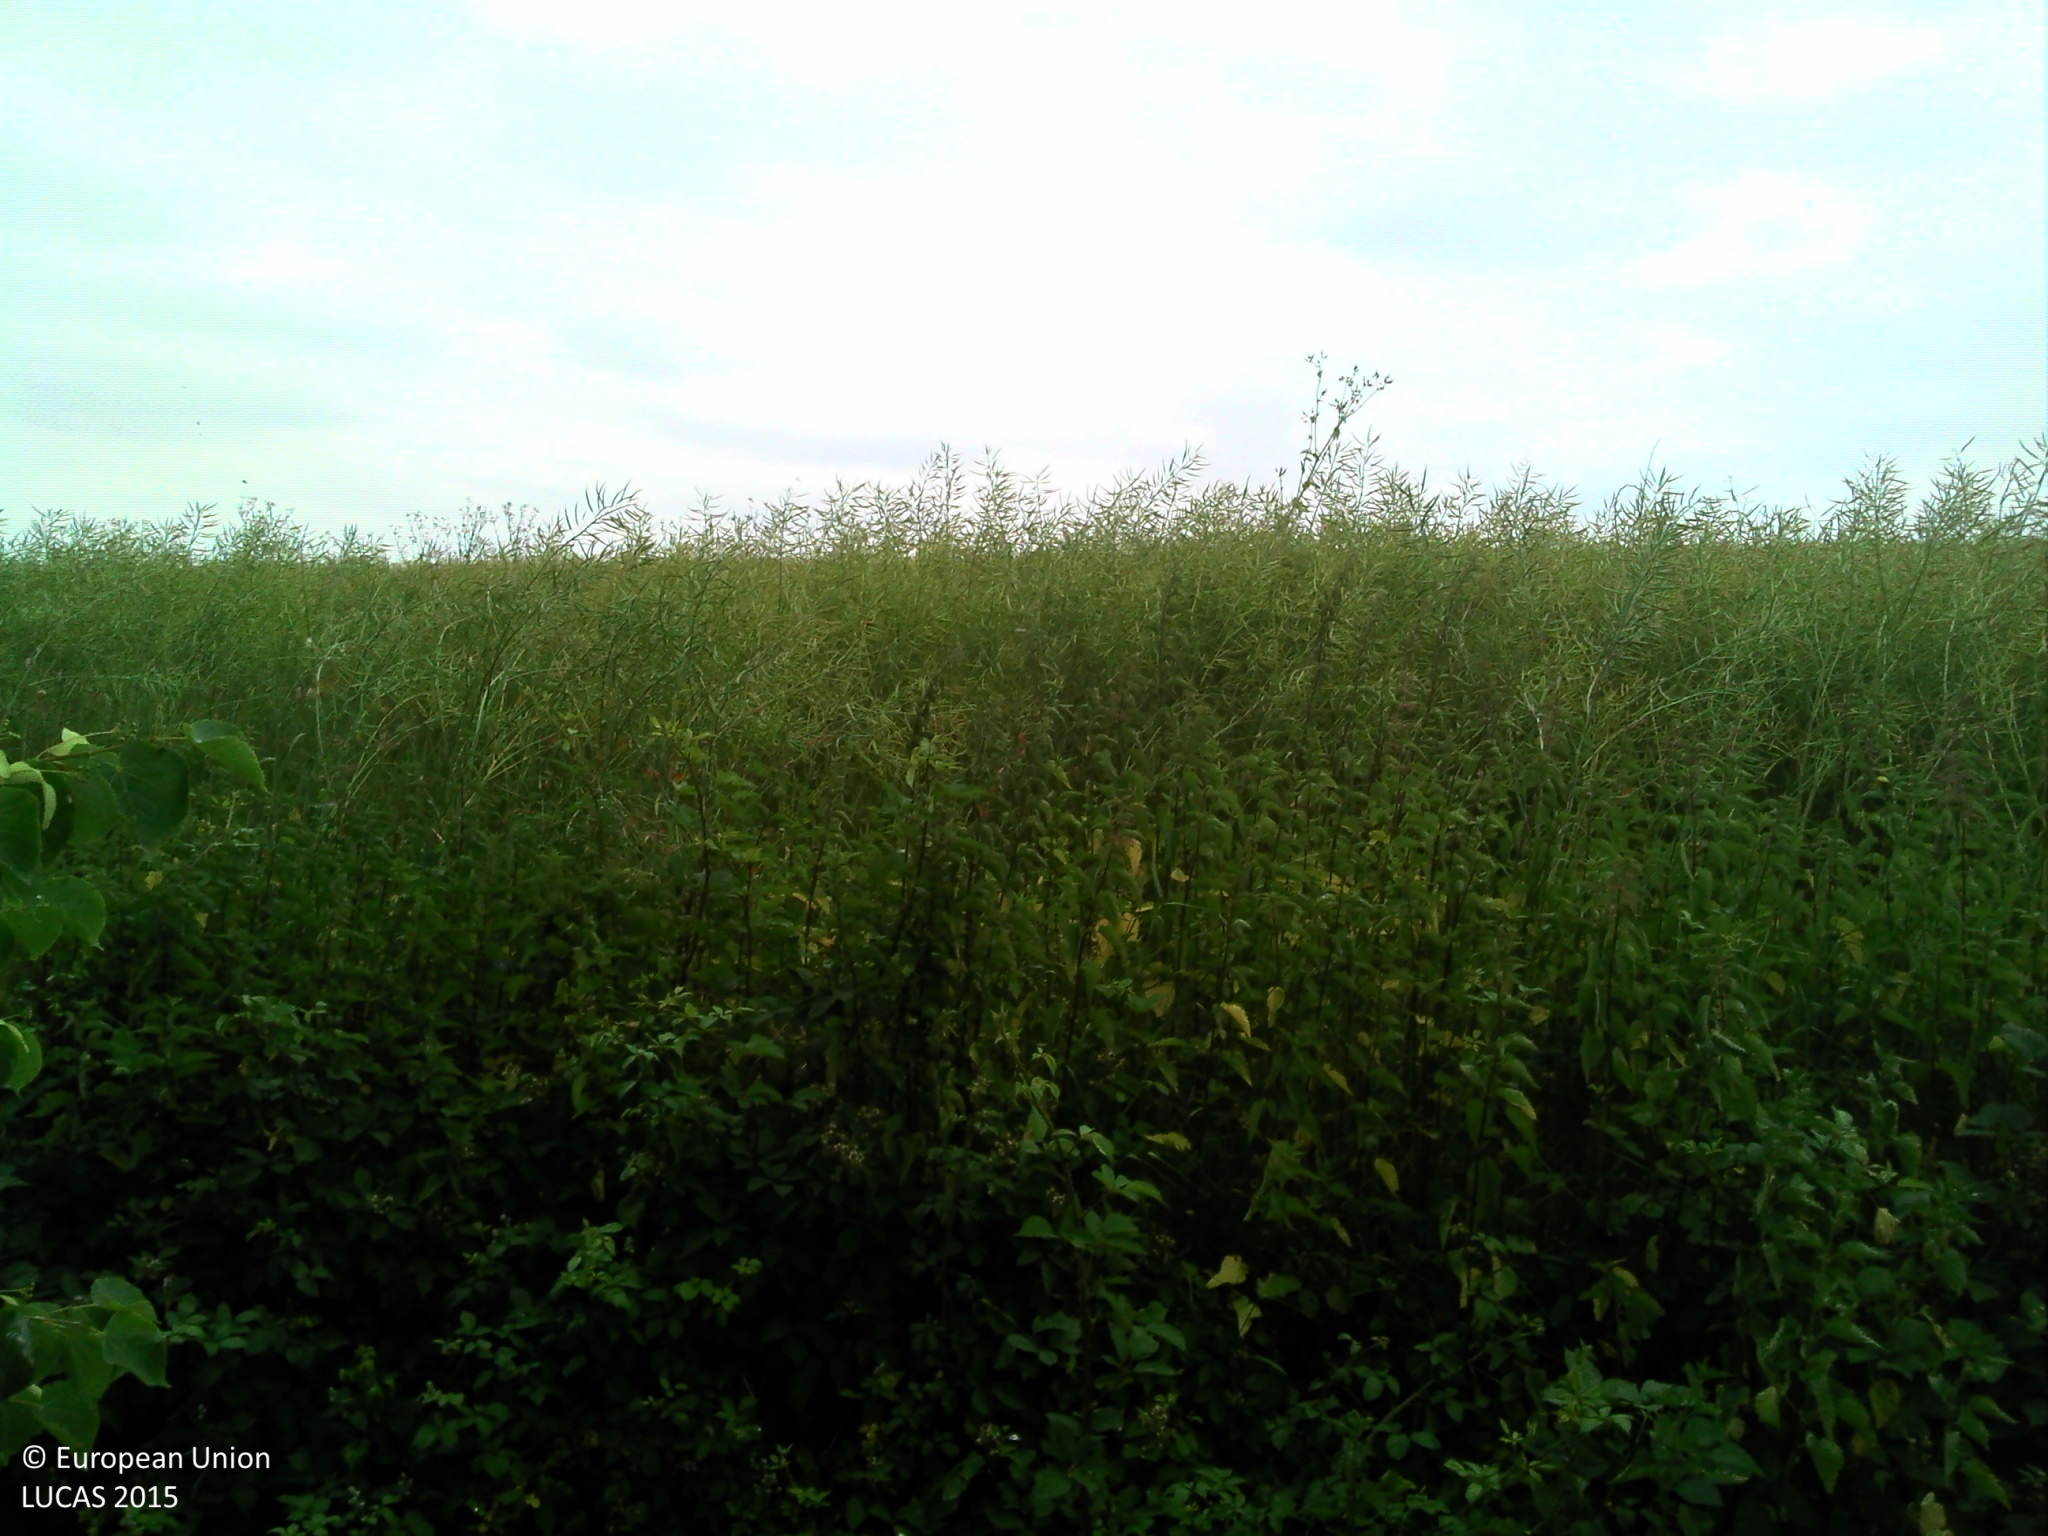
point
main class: Cropland
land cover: Rape and turnip rape
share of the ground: > 75 %
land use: Agriculture (excluding fallow land and kitchen gardens)
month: June
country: FR
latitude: 46.1221
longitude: 4.9170
